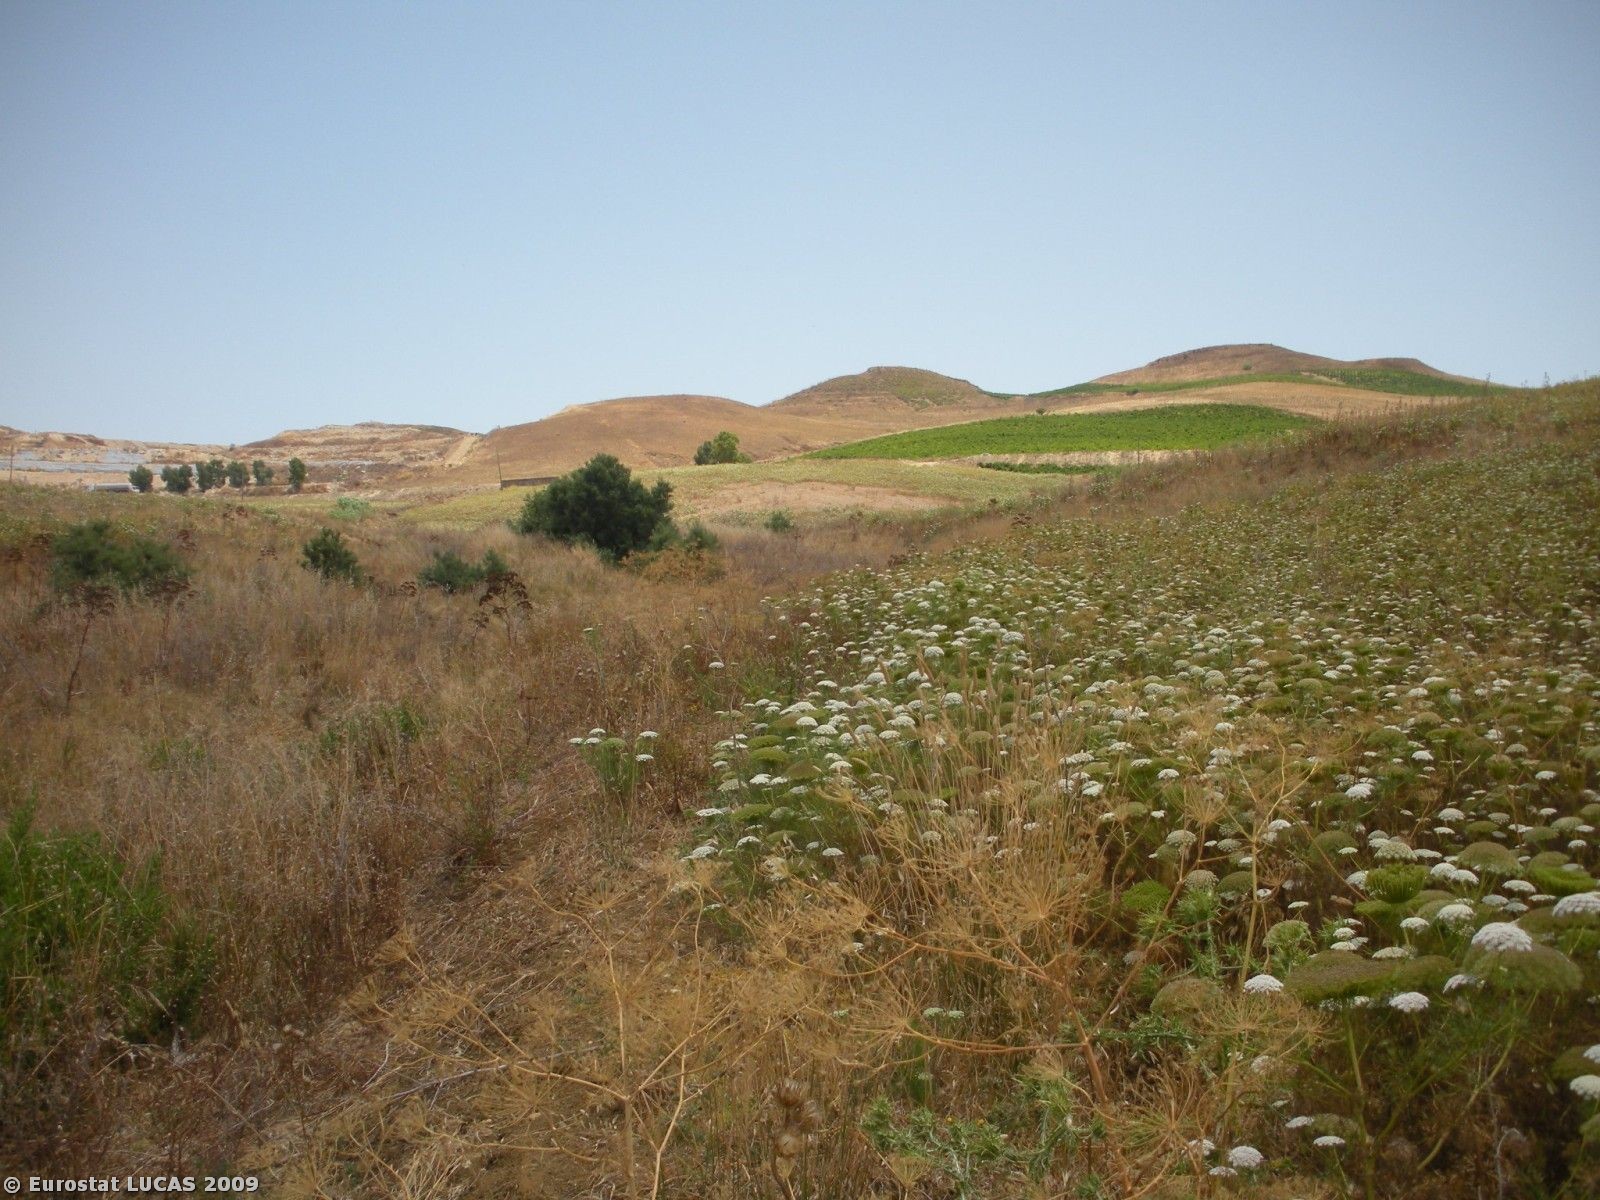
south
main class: Grassland
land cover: Grassland without tree/shrub cover
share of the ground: > 75 %
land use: Agriculture (excluding fallow land and kitchen gardens)
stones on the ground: > 50 %
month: July
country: IT
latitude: 37.8747
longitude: 12.6295
